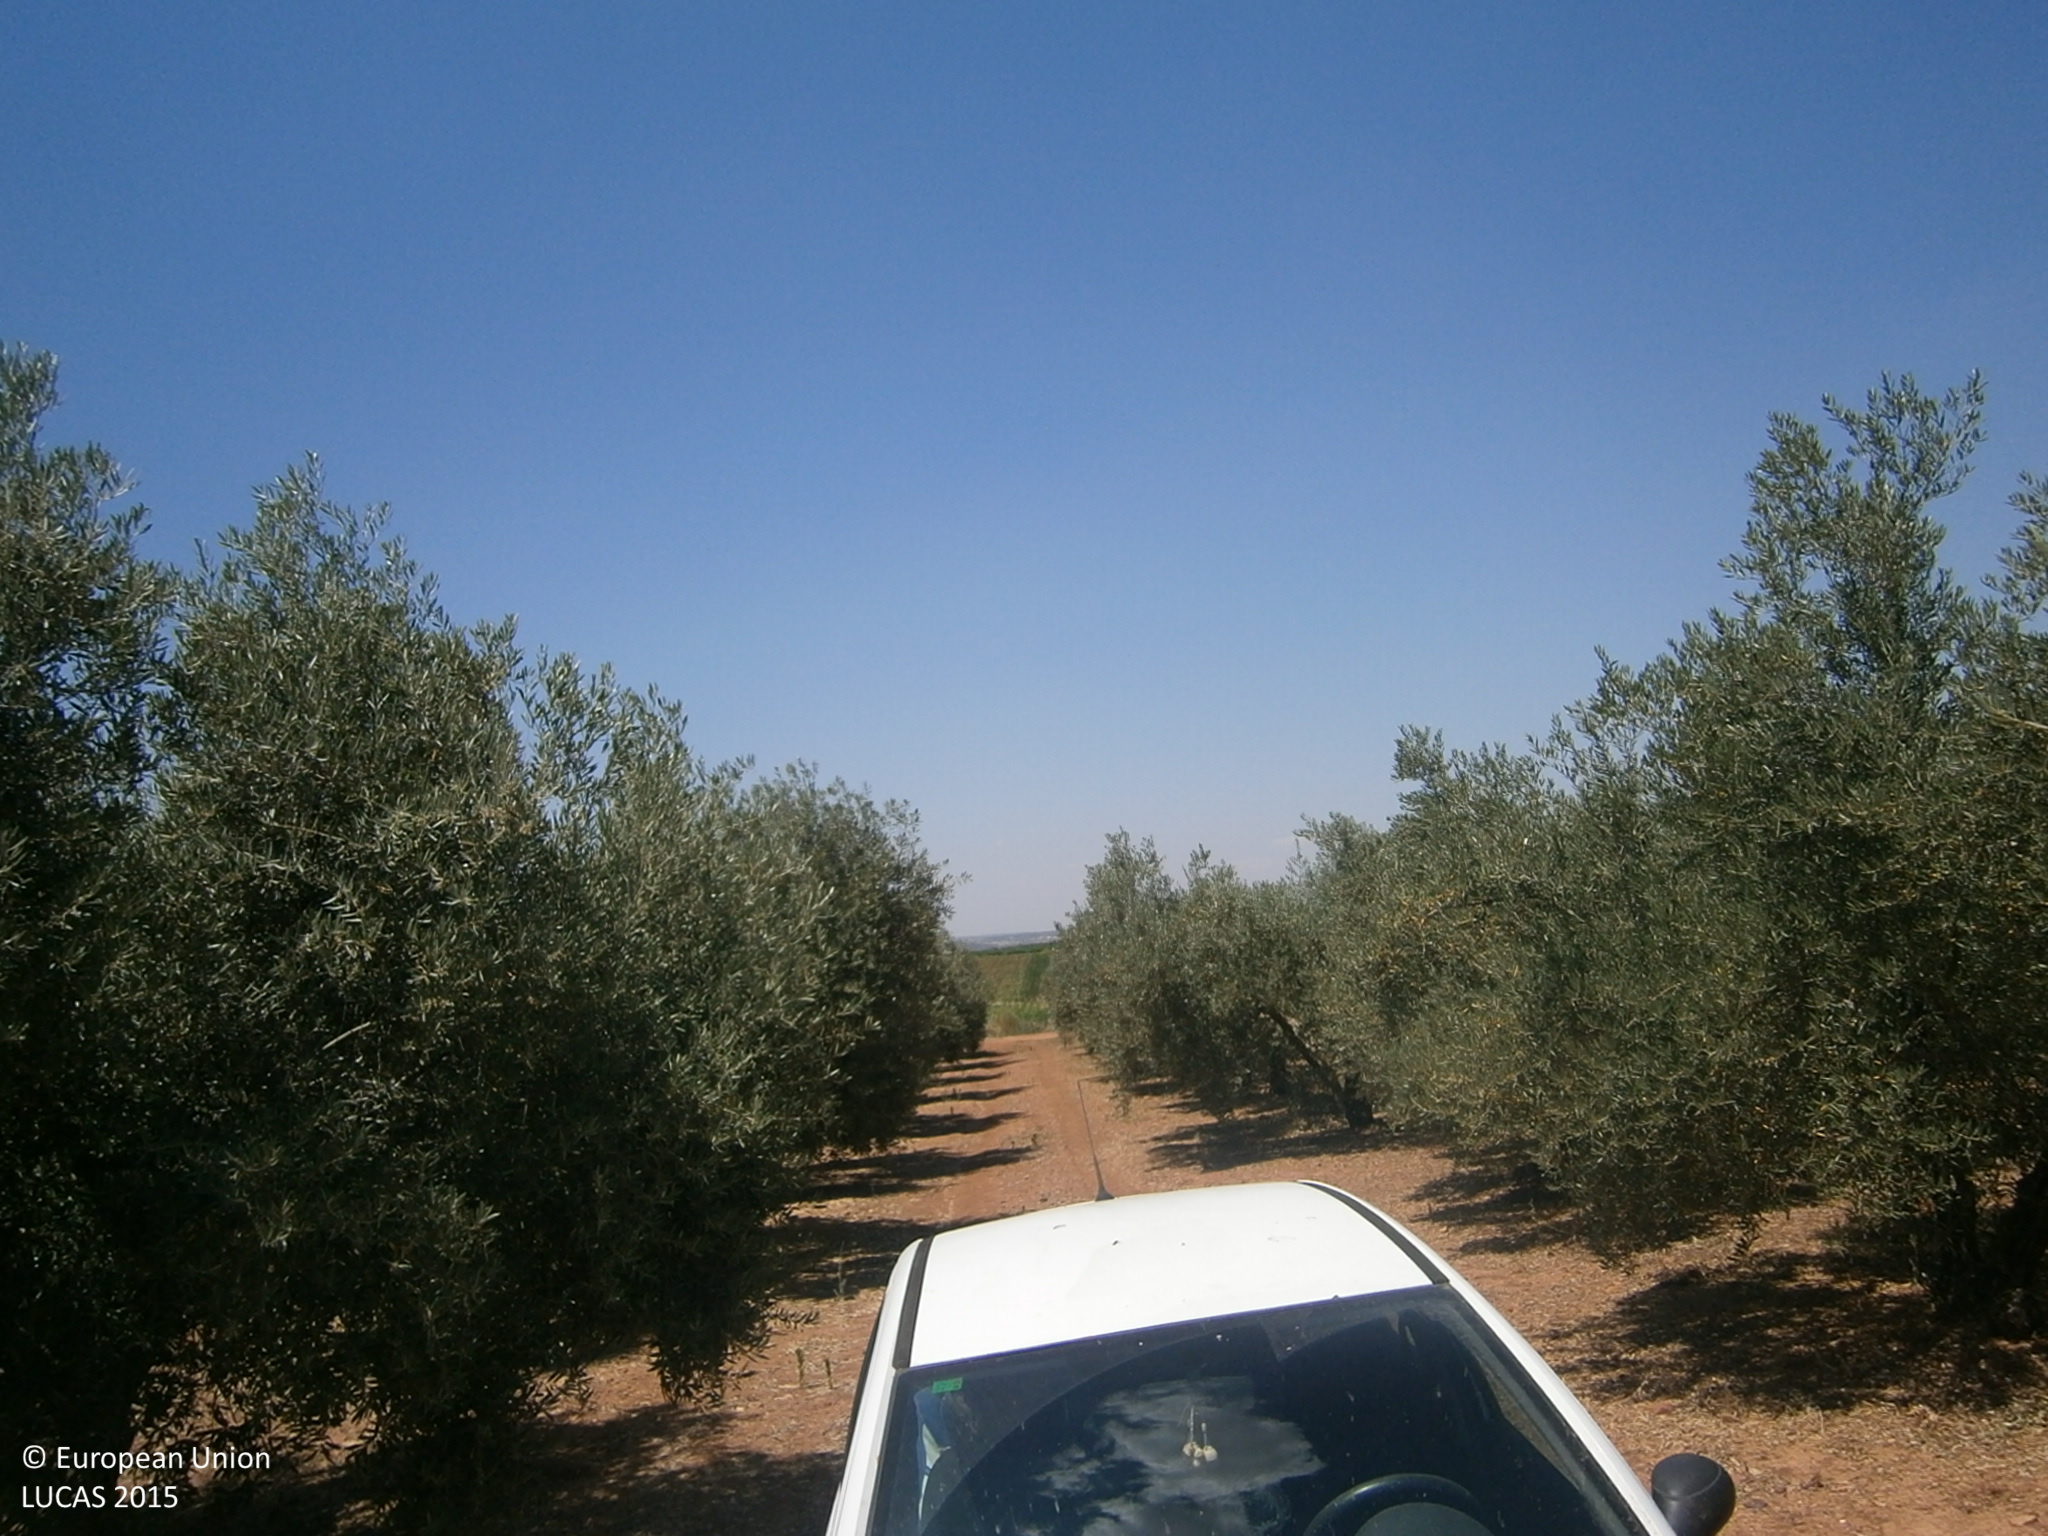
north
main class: Cropland
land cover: Olive groves
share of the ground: 50 - 75 %
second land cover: Spontaneously vegetated surfaces
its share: > 75 %
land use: Agriculture (excluding fallow land and kitchen gardens)
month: June
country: ES
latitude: 38.8344
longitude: -6.2162
